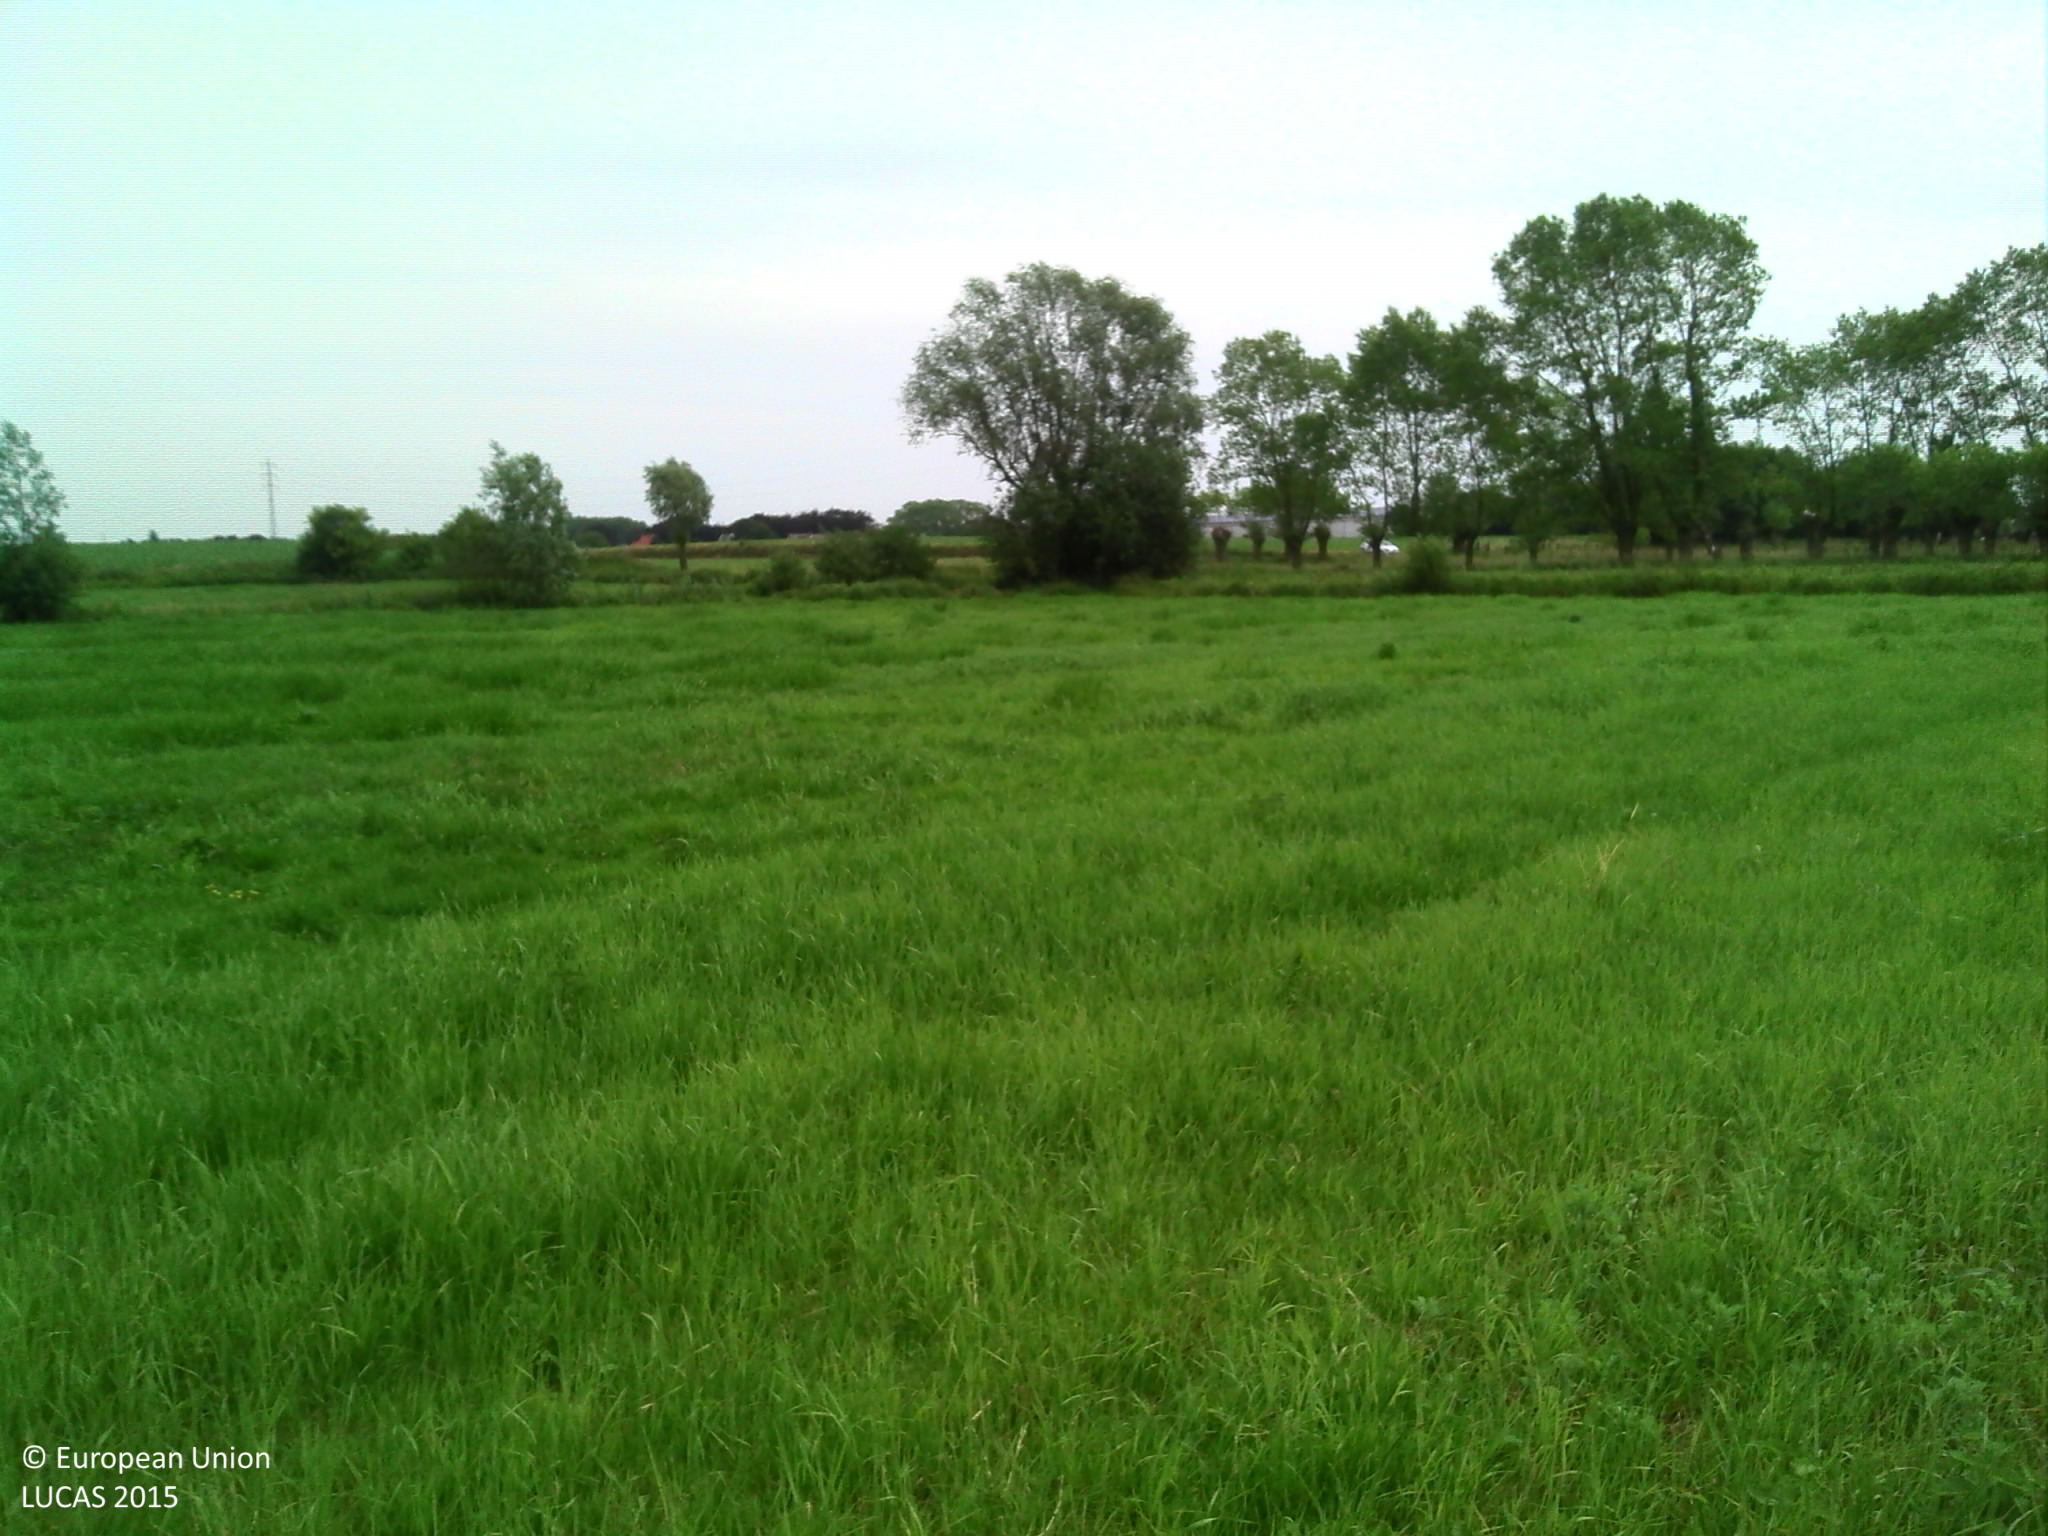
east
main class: Grassland
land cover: Grassland without tree/shrub cover
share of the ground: > 75 %
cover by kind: herbaceous plants 100 %
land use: Agriculture (excluding fallow land and kitchen gardens)
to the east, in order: Grassland without tree/shrub cover; Rivers and streams; Grassland without tree/shrub cover; Rivers and streams; Grassland without tree/shrub cover; Ditches and canals; Grassland without tree/shrub cover; Ditches and canals; Fences; Grassland without tree/shrub cover; Fences; Lines of trees; Grassland without tree/shrub cover; Tracks; Sugar beet
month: June
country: BE
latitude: 50.9704
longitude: 3.4556
